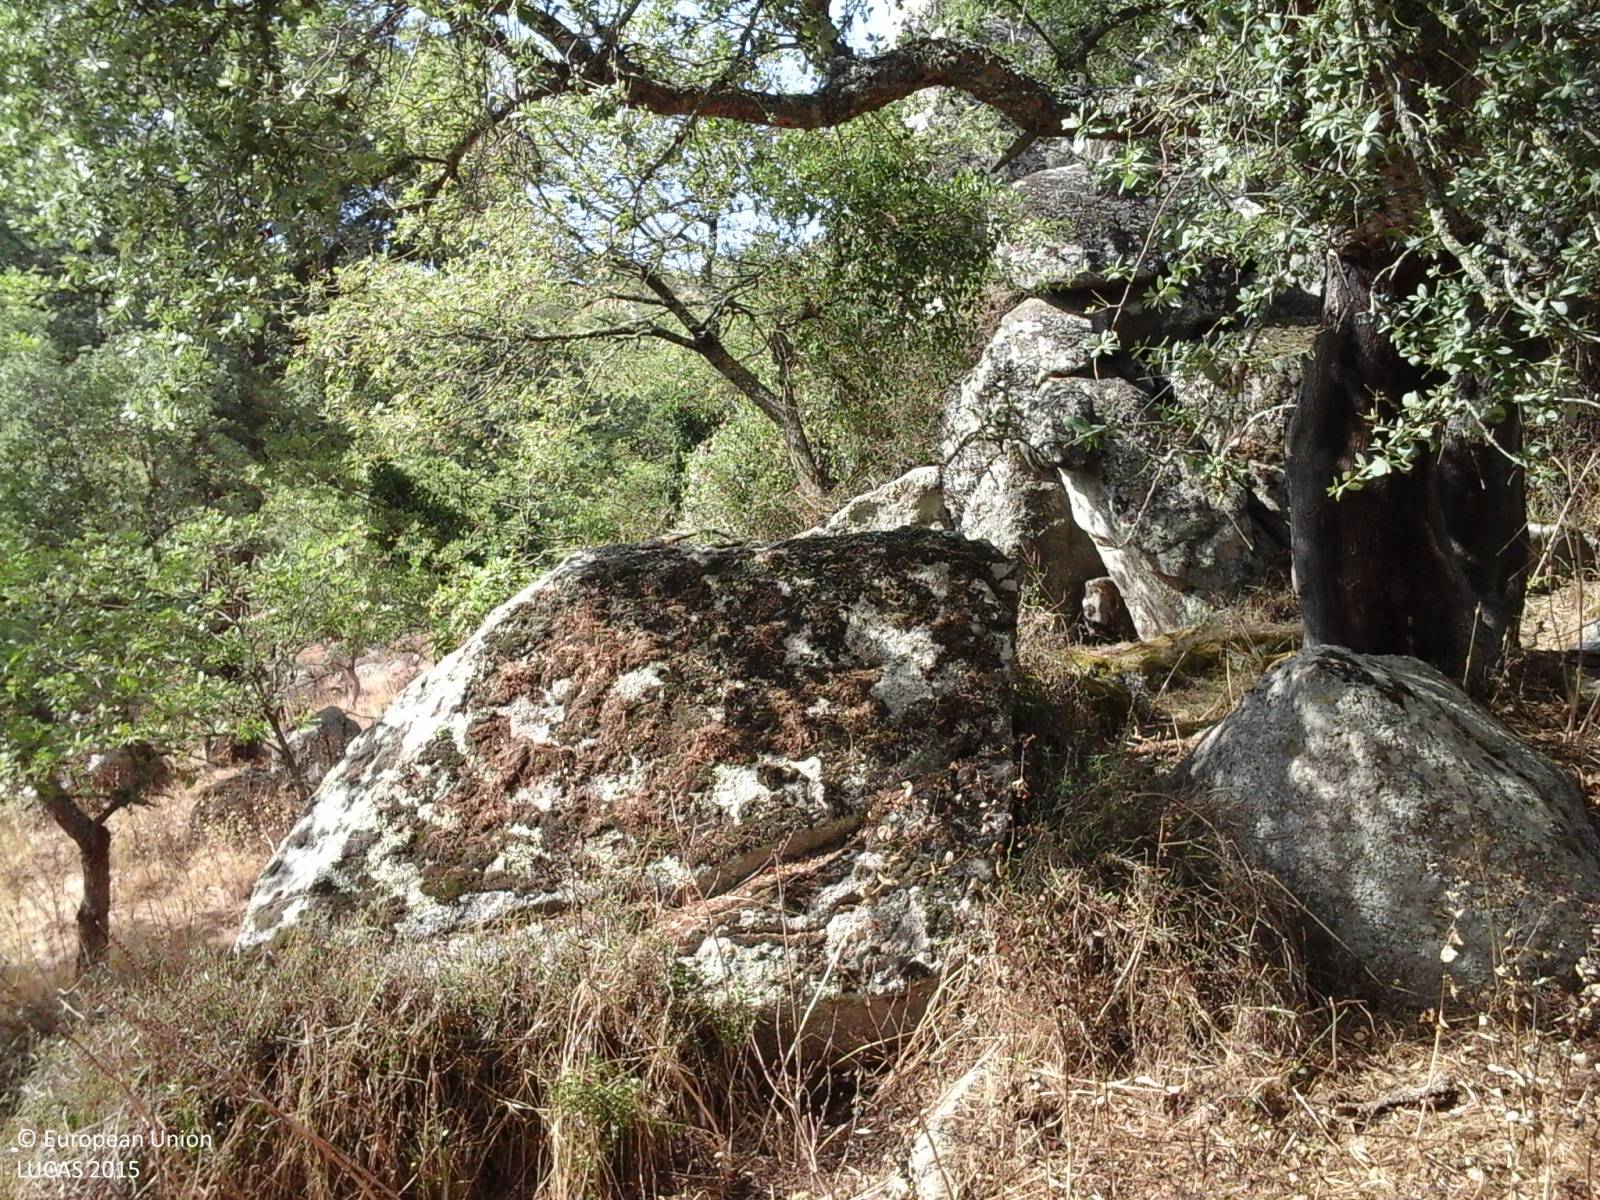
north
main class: Woodland
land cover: Broadleaved woodland
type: broadleaved evergreen forest
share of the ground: > 75 %
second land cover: Grassland without tree/shrub cover
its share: > 75 %
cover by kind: herbaceous plants 55 %, shrubs 35 %, broadleaved forest trees 10 %
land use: Forestry
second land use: Agriculture (excluding fallow land and kitchen gardens)
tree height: > 5 m
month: August
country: IT
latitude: 40.5353
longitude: 9.1660
